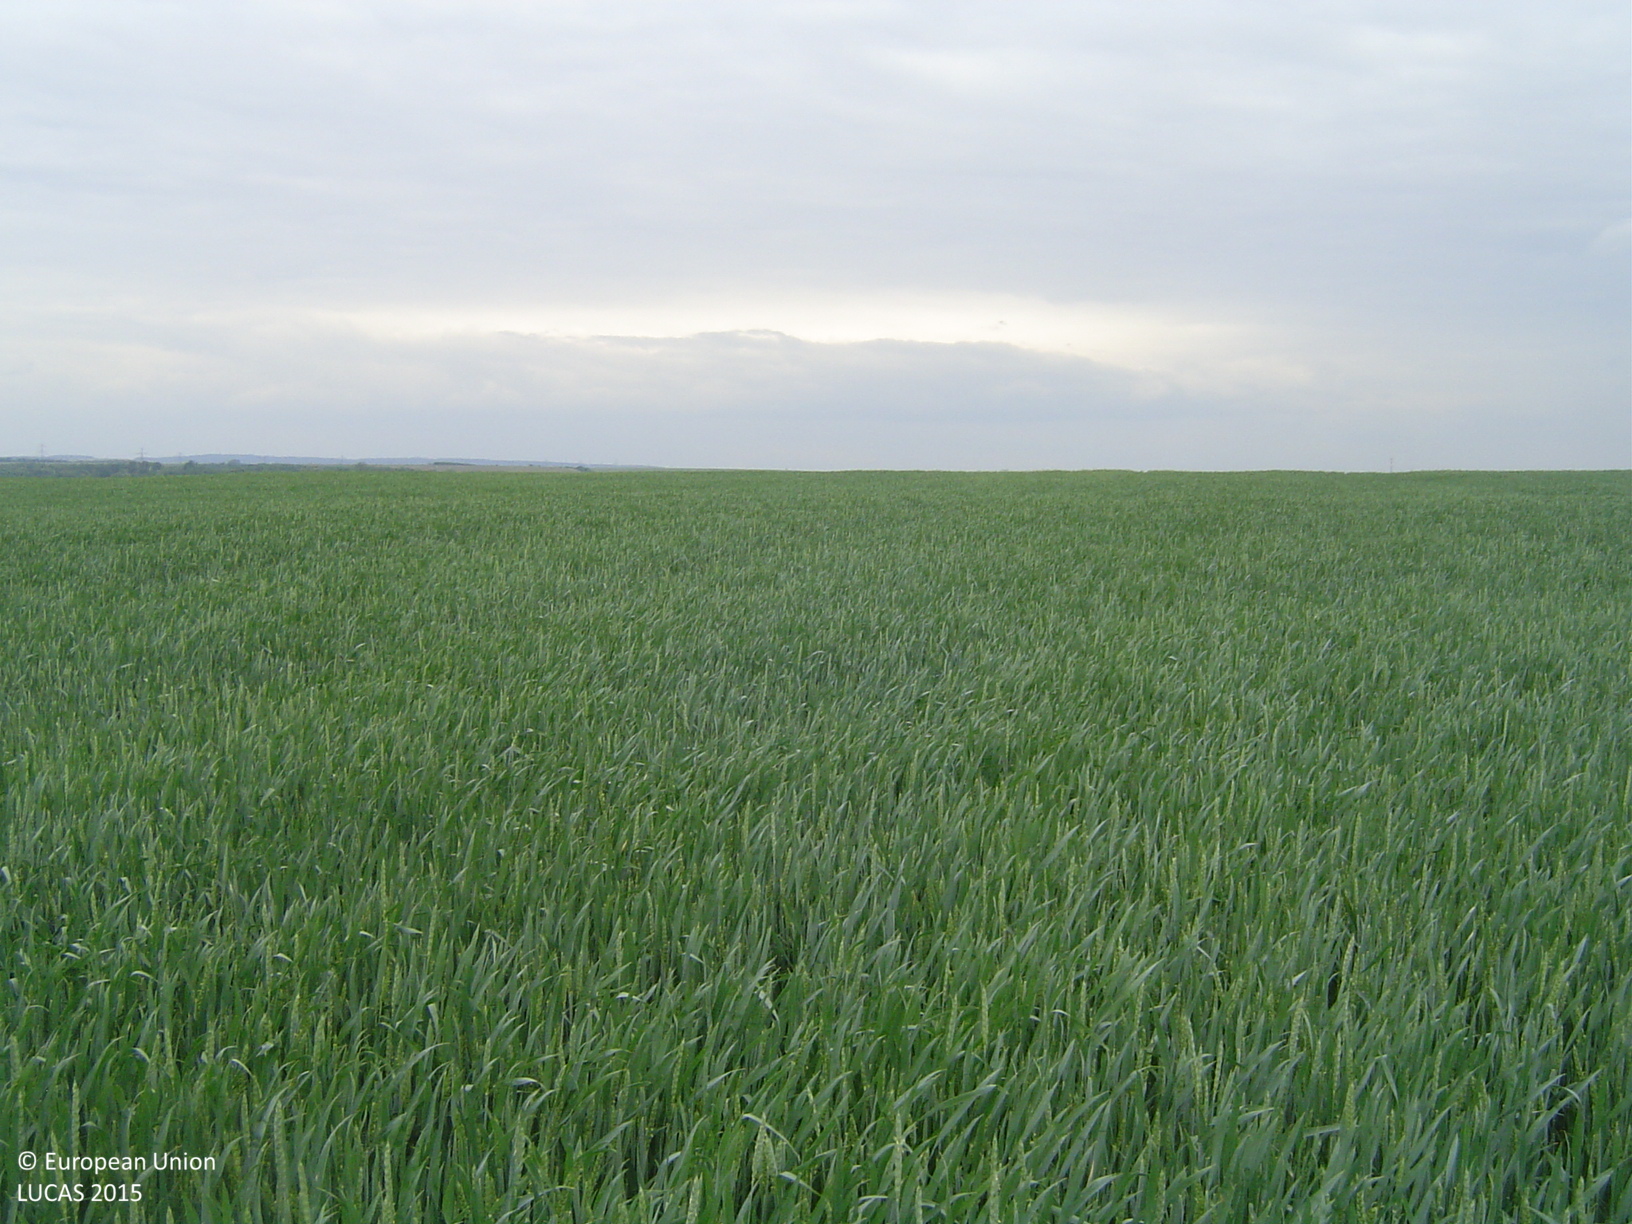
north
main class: Cropland
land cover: Common wheat
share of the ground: > 75 %
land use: Agriculture (excluding fallow land and kitchen gardens)
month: May
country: CZ
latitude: 48.7740
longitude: 16.1420
